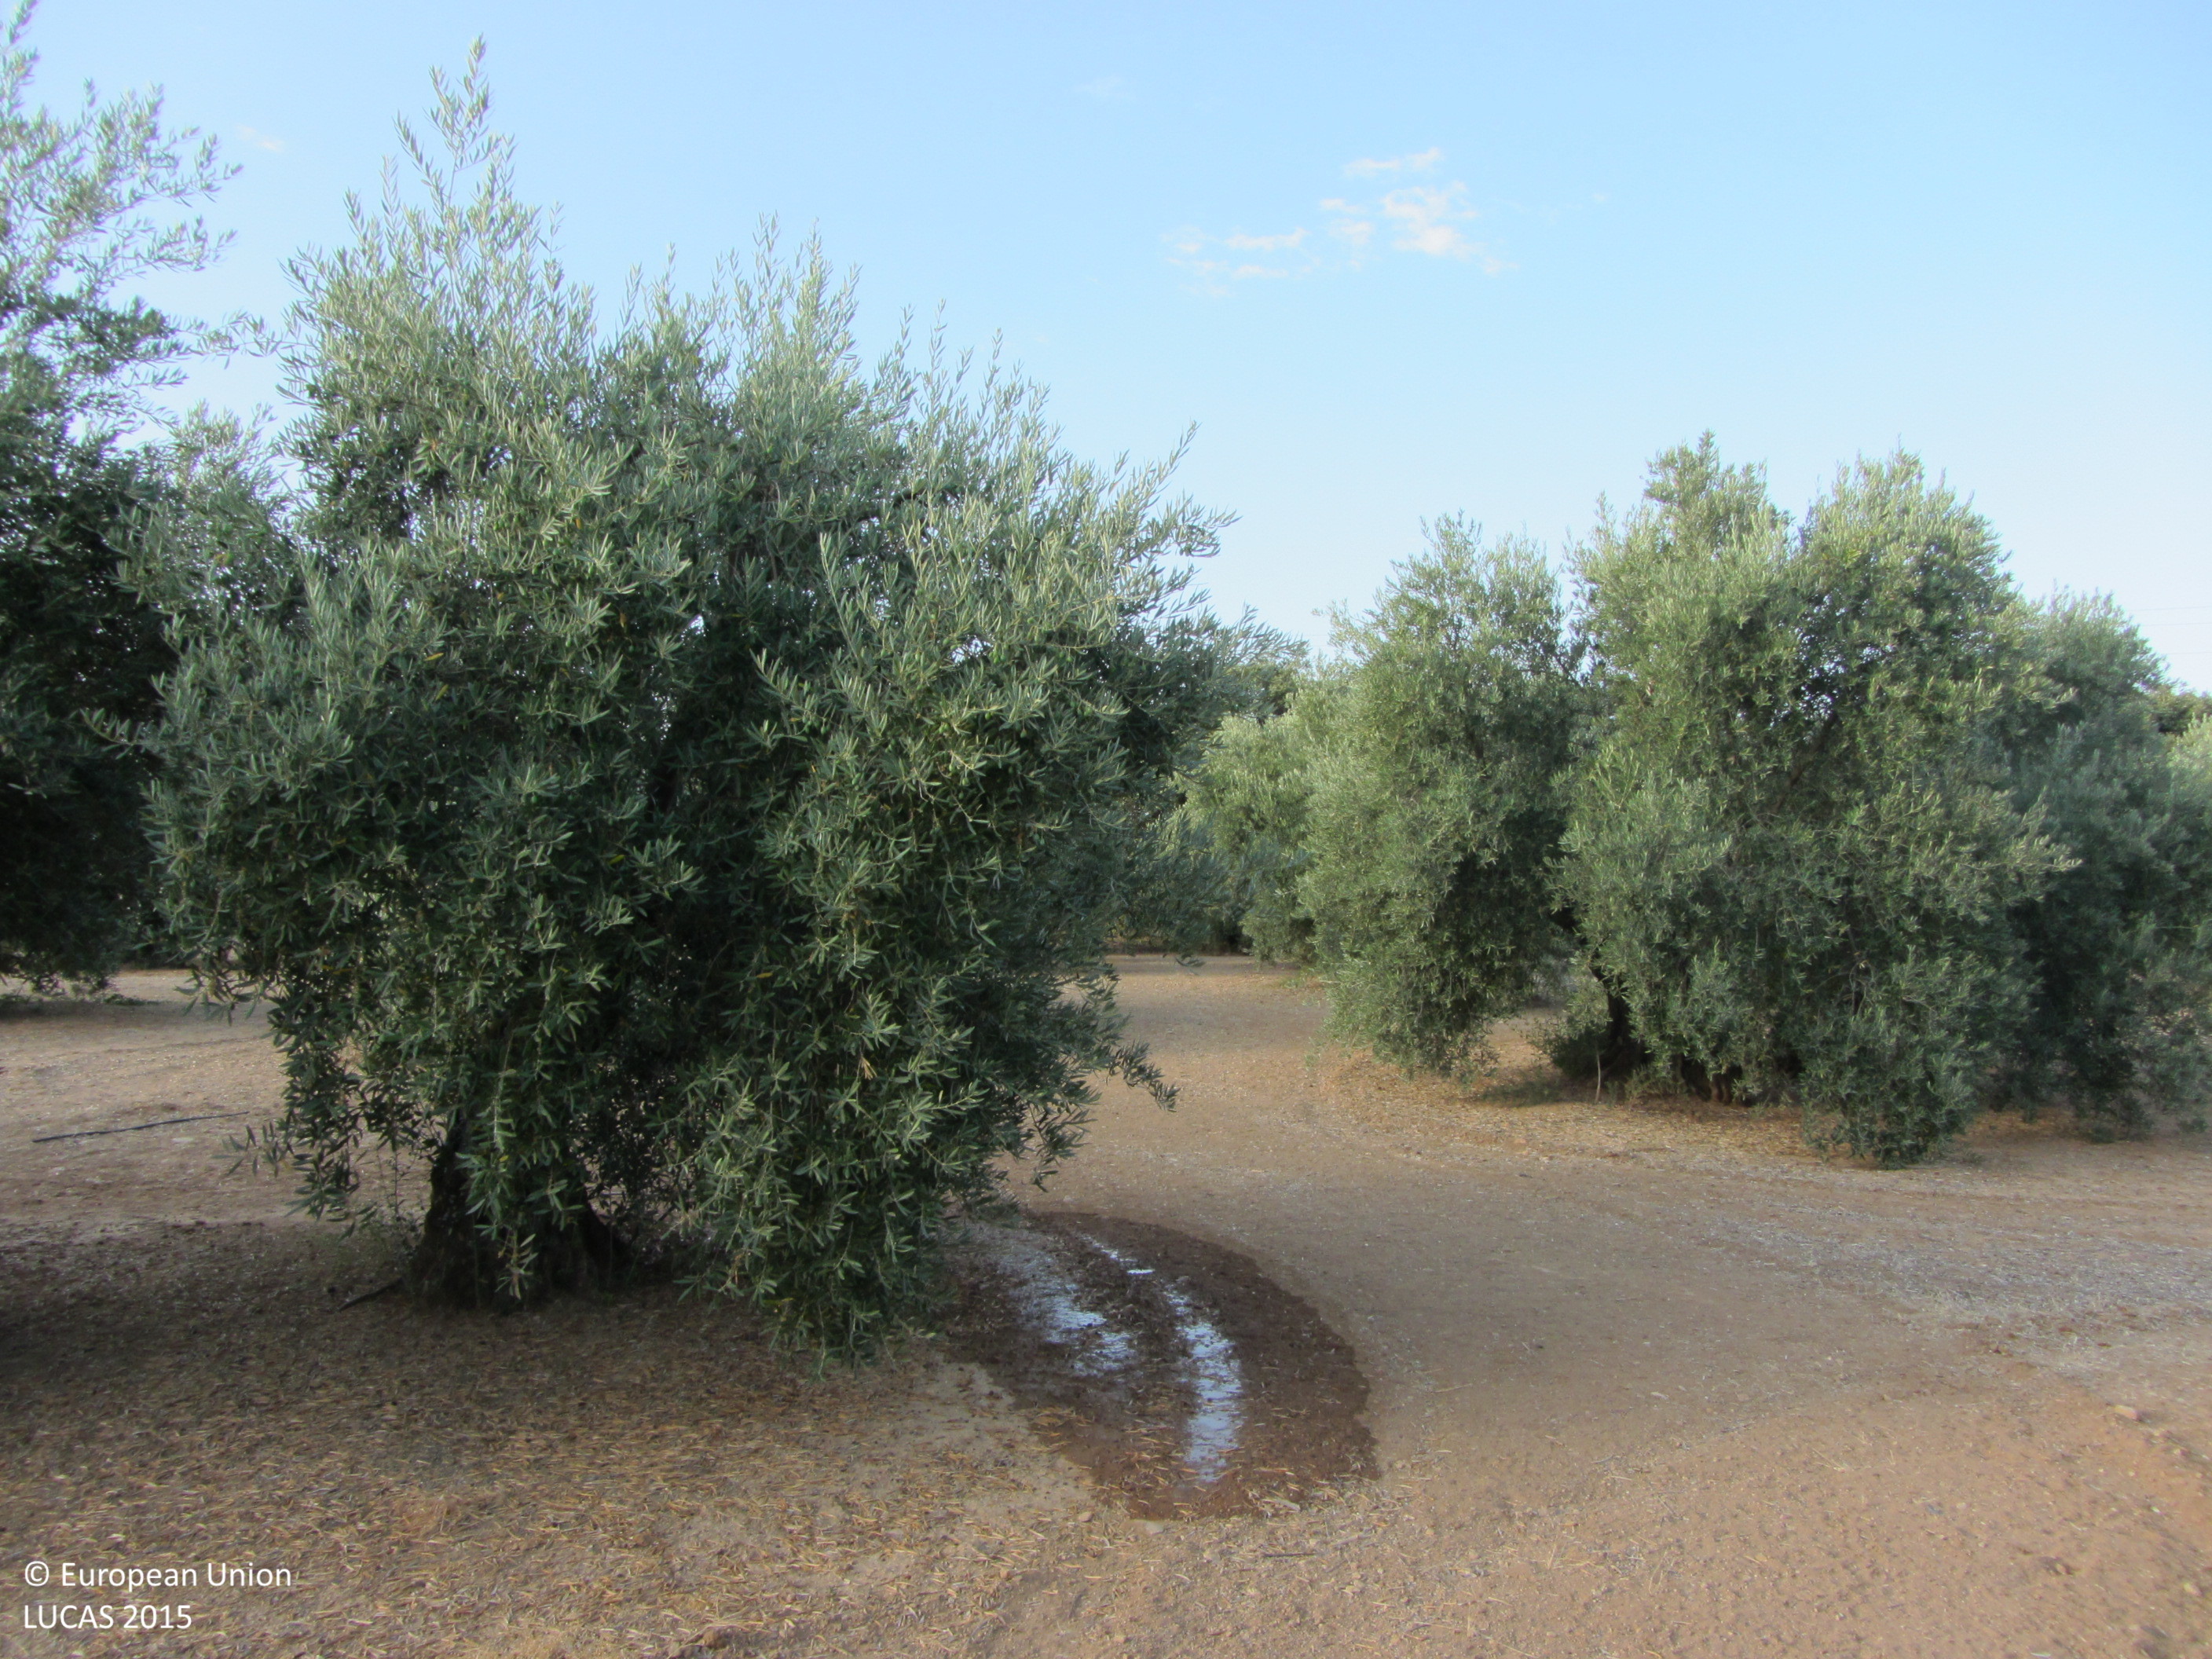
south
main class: Cropland
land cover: Olive groves
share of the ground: 25 - 50 %
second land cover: Other bare soil
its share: > 75 %
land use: Agriculture (excluding fallow land and kitchen gardens)
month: July
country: ES
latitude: 38.0406
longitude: -3.4119
